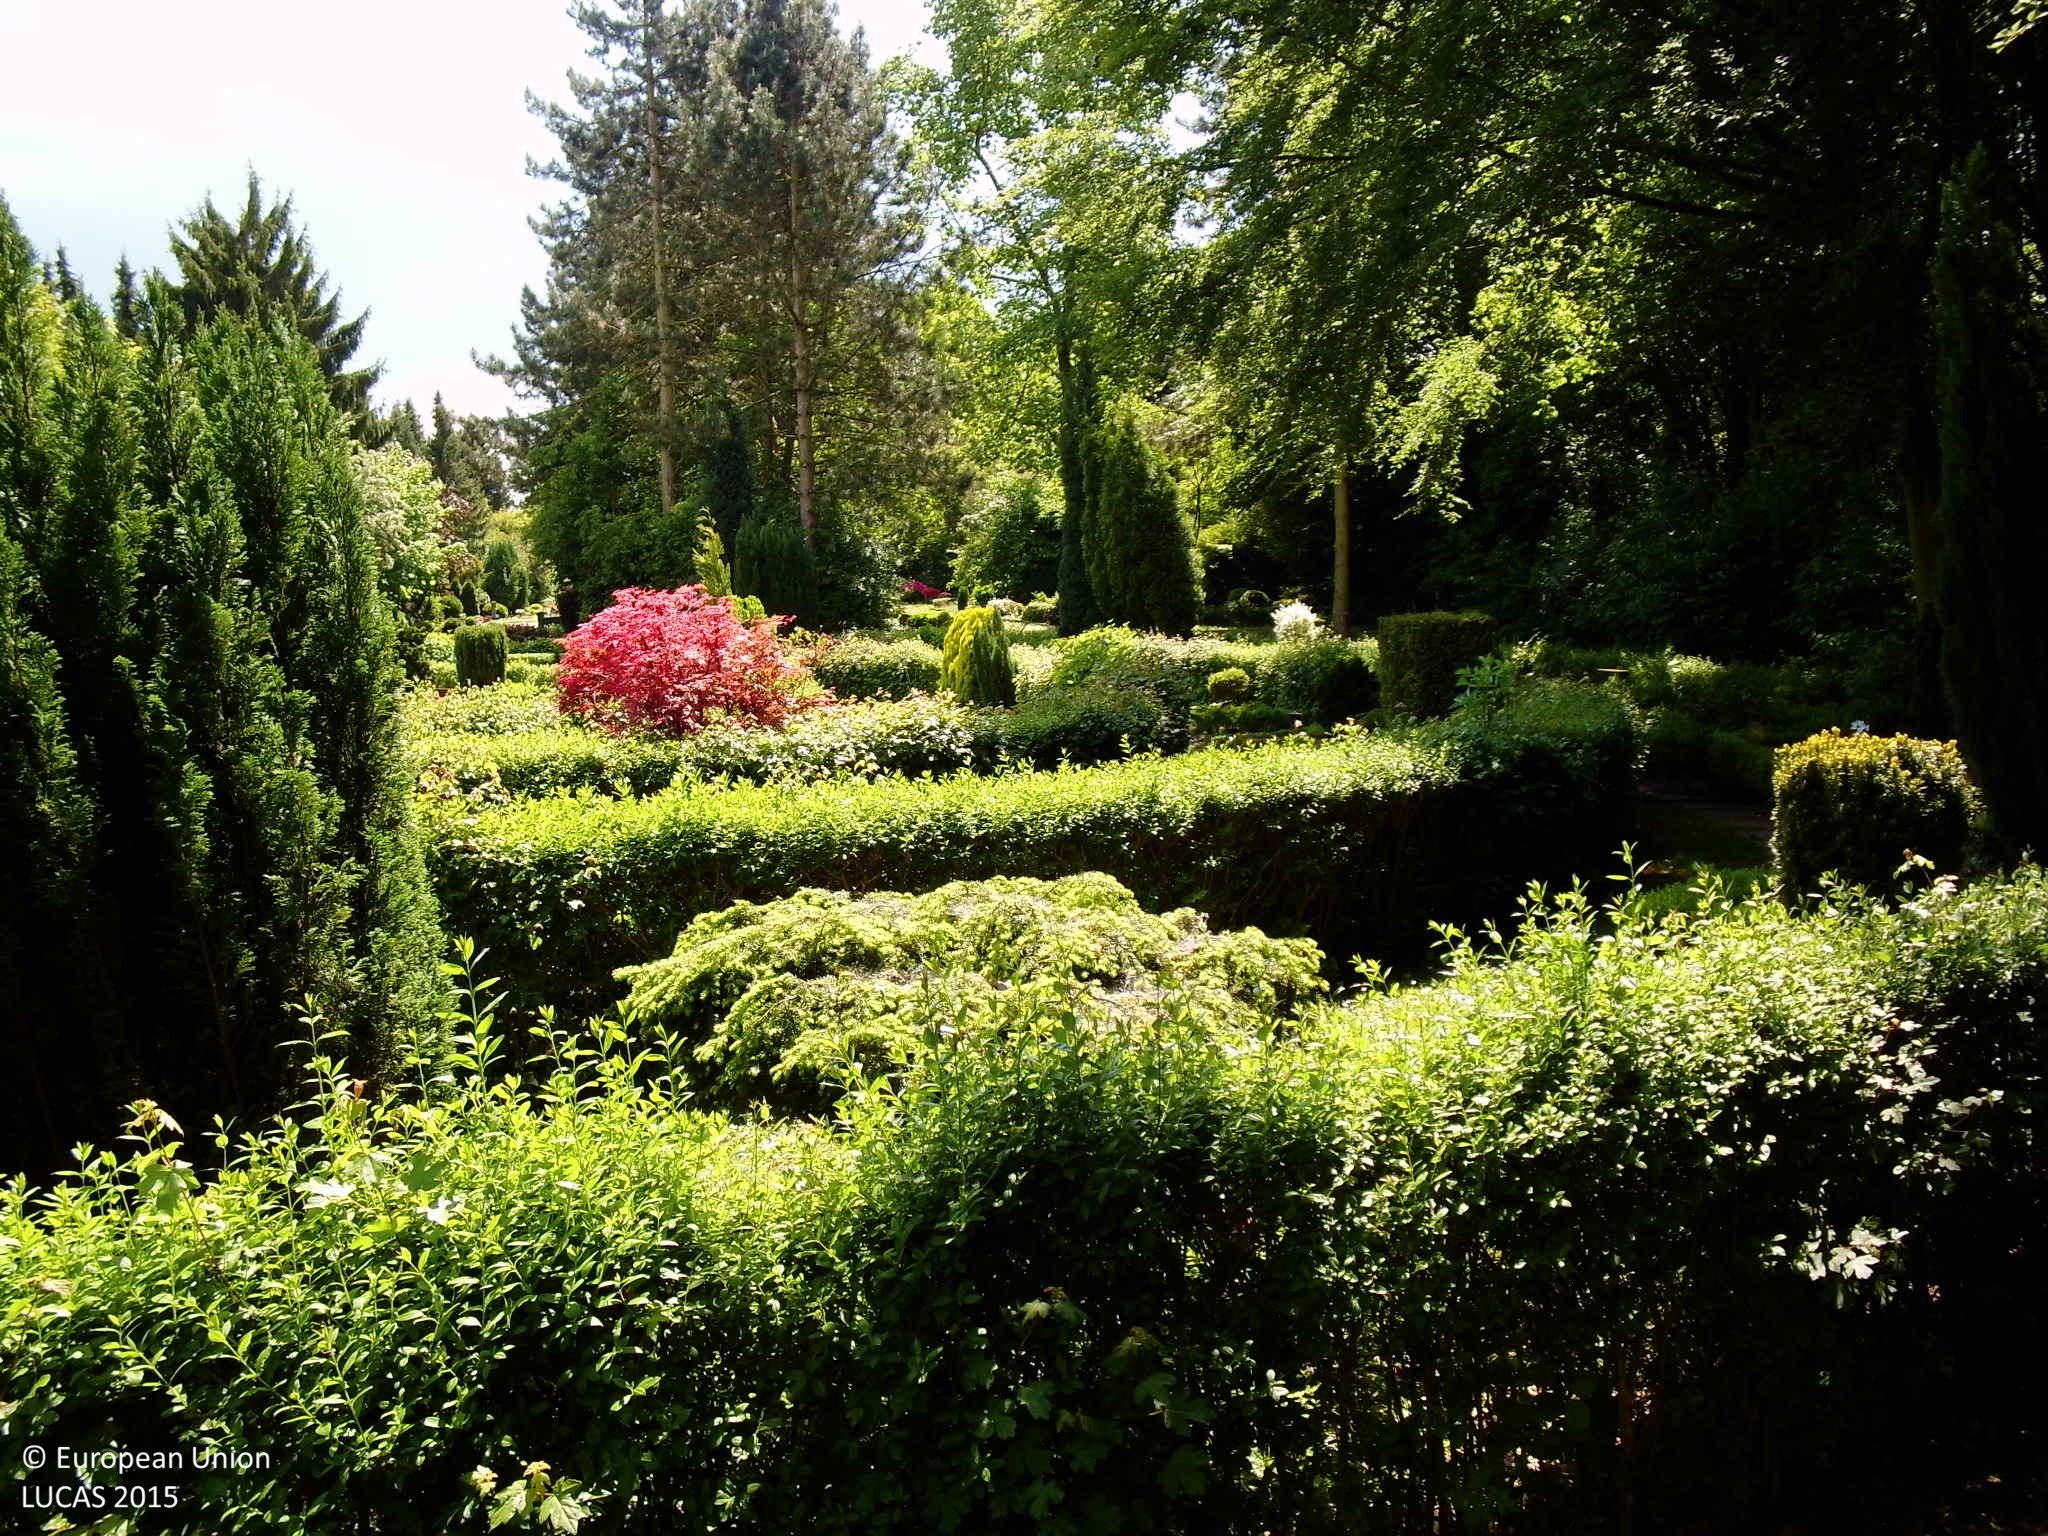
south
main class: Woodland
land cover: Broadleaved woodland
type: beech forest
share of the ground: 25 - 50 %
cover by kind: broadleaved forest trees 40 %, herbaceous plants 30 %, shrubs 20 %, consolidated bare surface 5 %, unconsolidated bare surface 5 %
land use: Community services
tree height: > 5 m
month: May
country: DE
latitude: 51.6293
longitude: 7.3854
